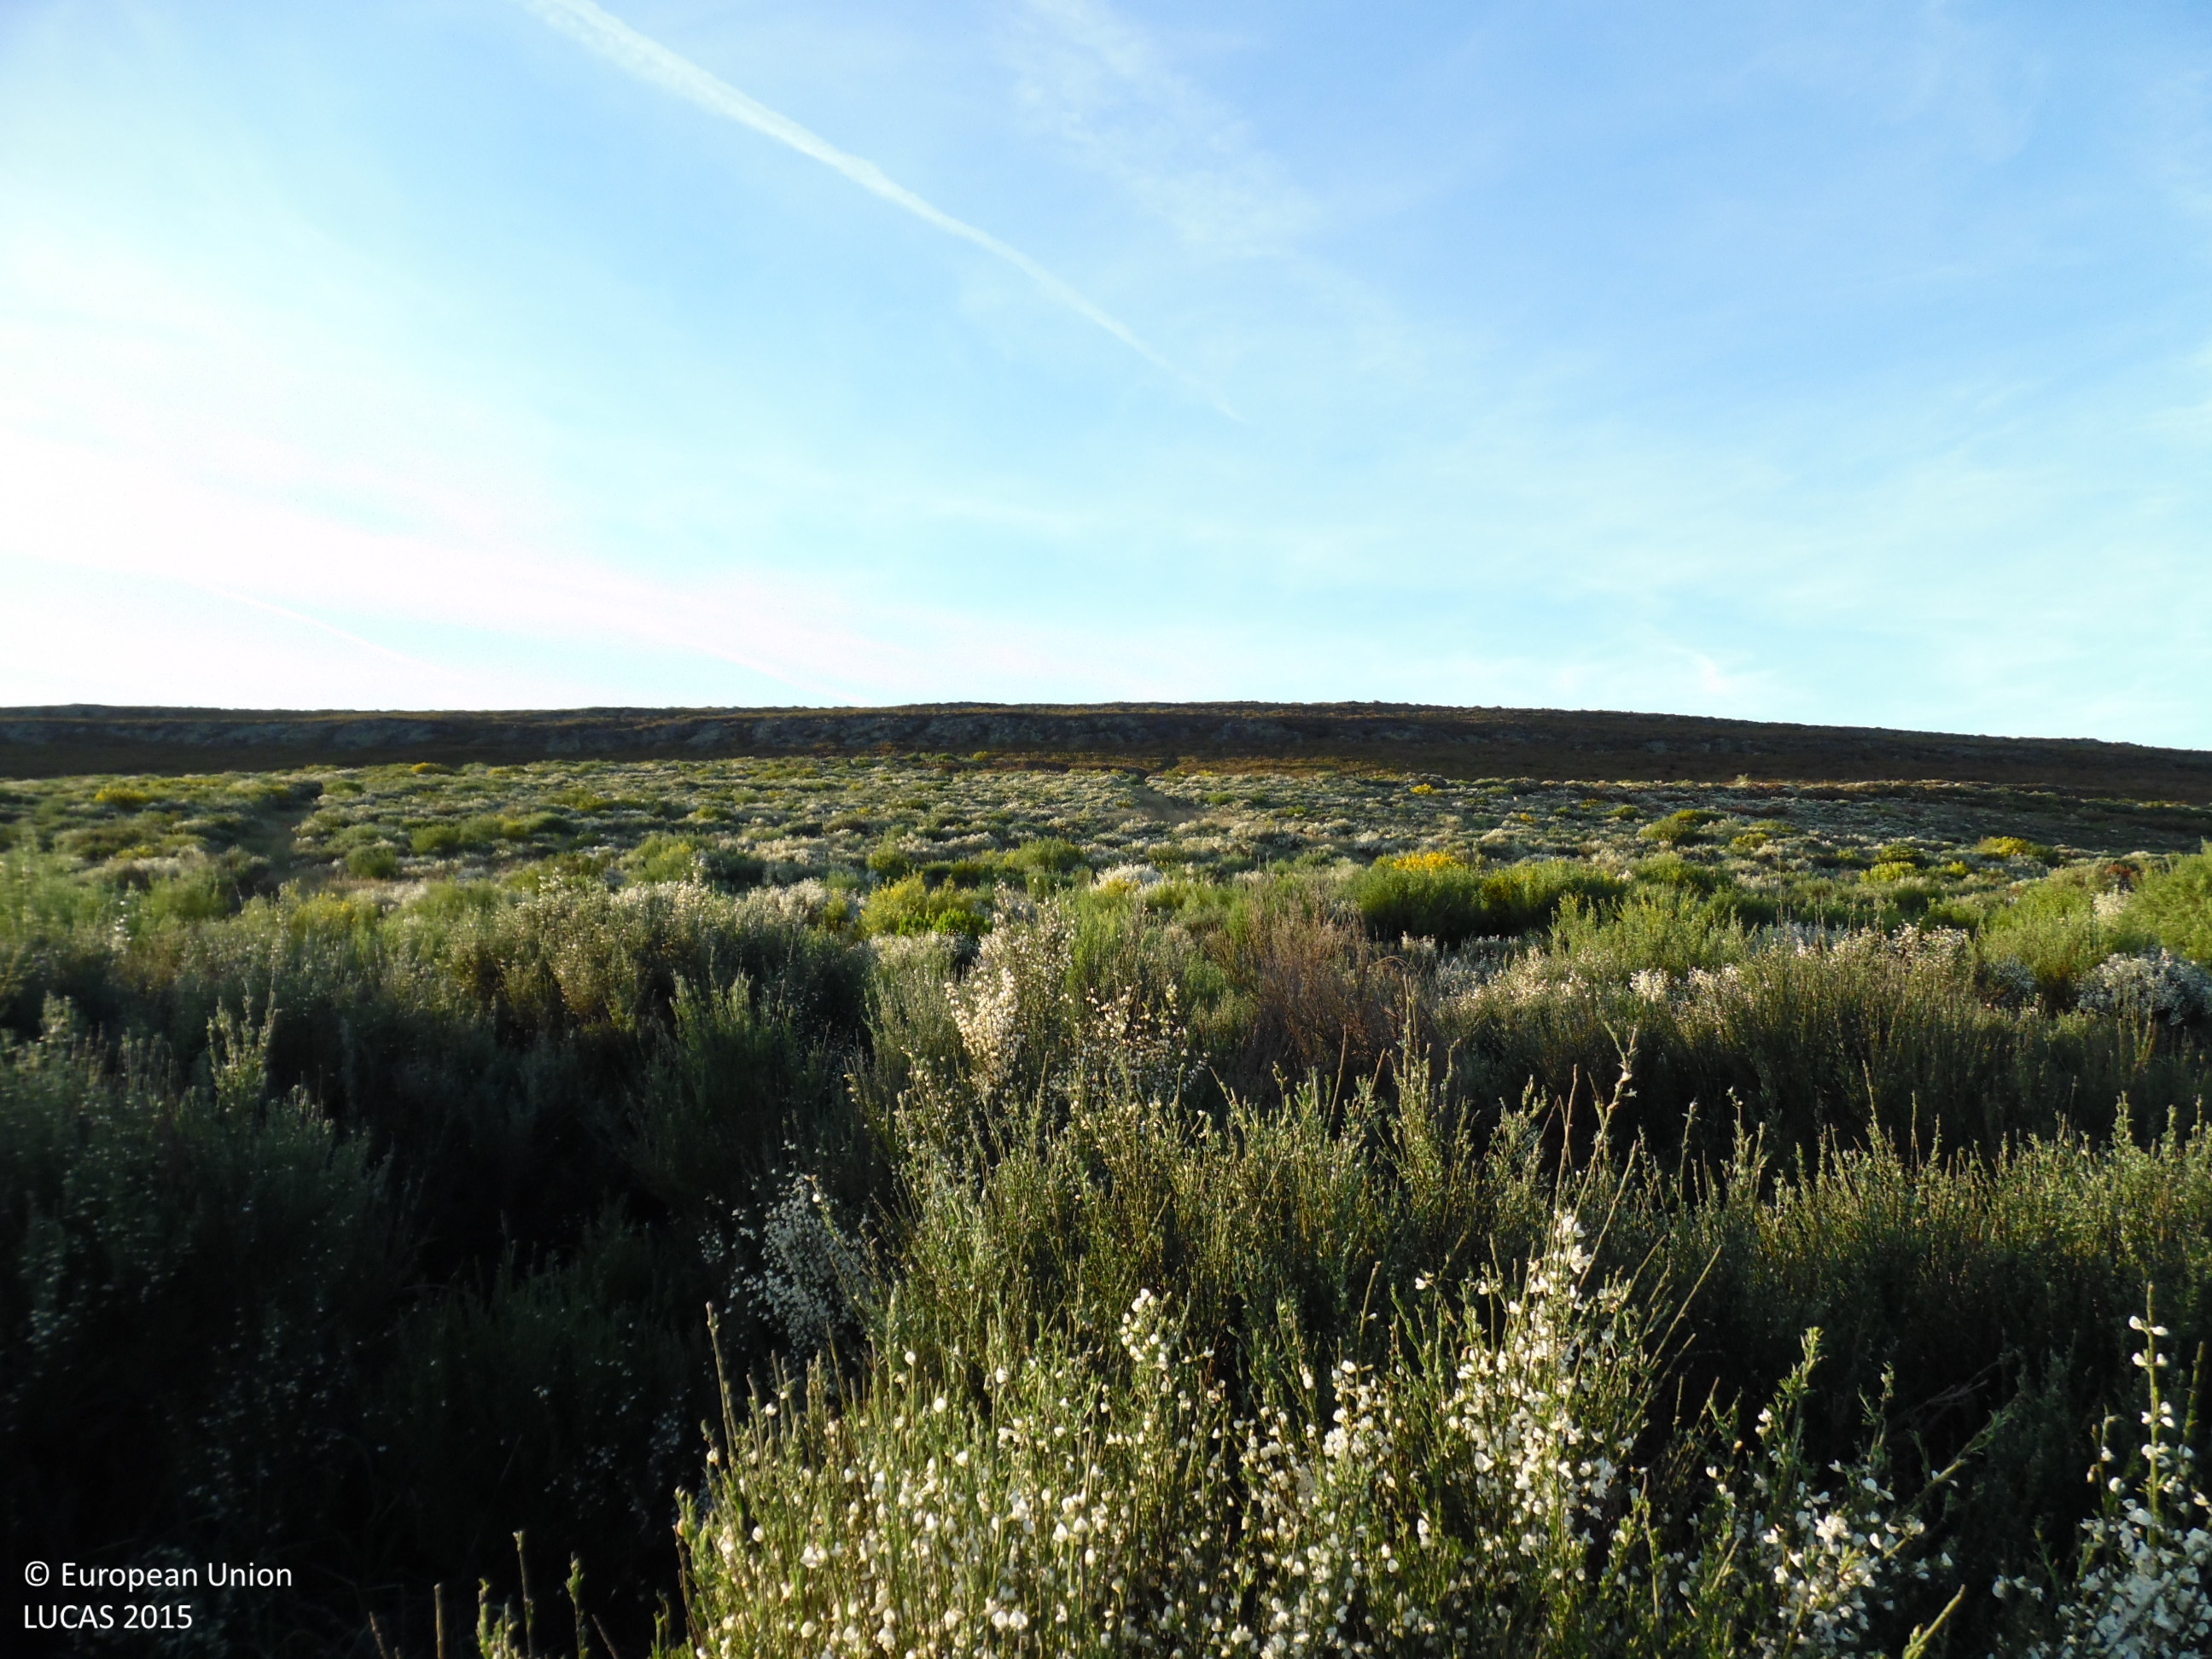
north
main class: Shrubland
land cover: Shrubland without tree cover
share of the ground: > 75 %
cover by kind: shrubs 100 %
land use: Abandoned areas
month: May
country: ES
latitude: 42.6350
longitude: -6.1463
